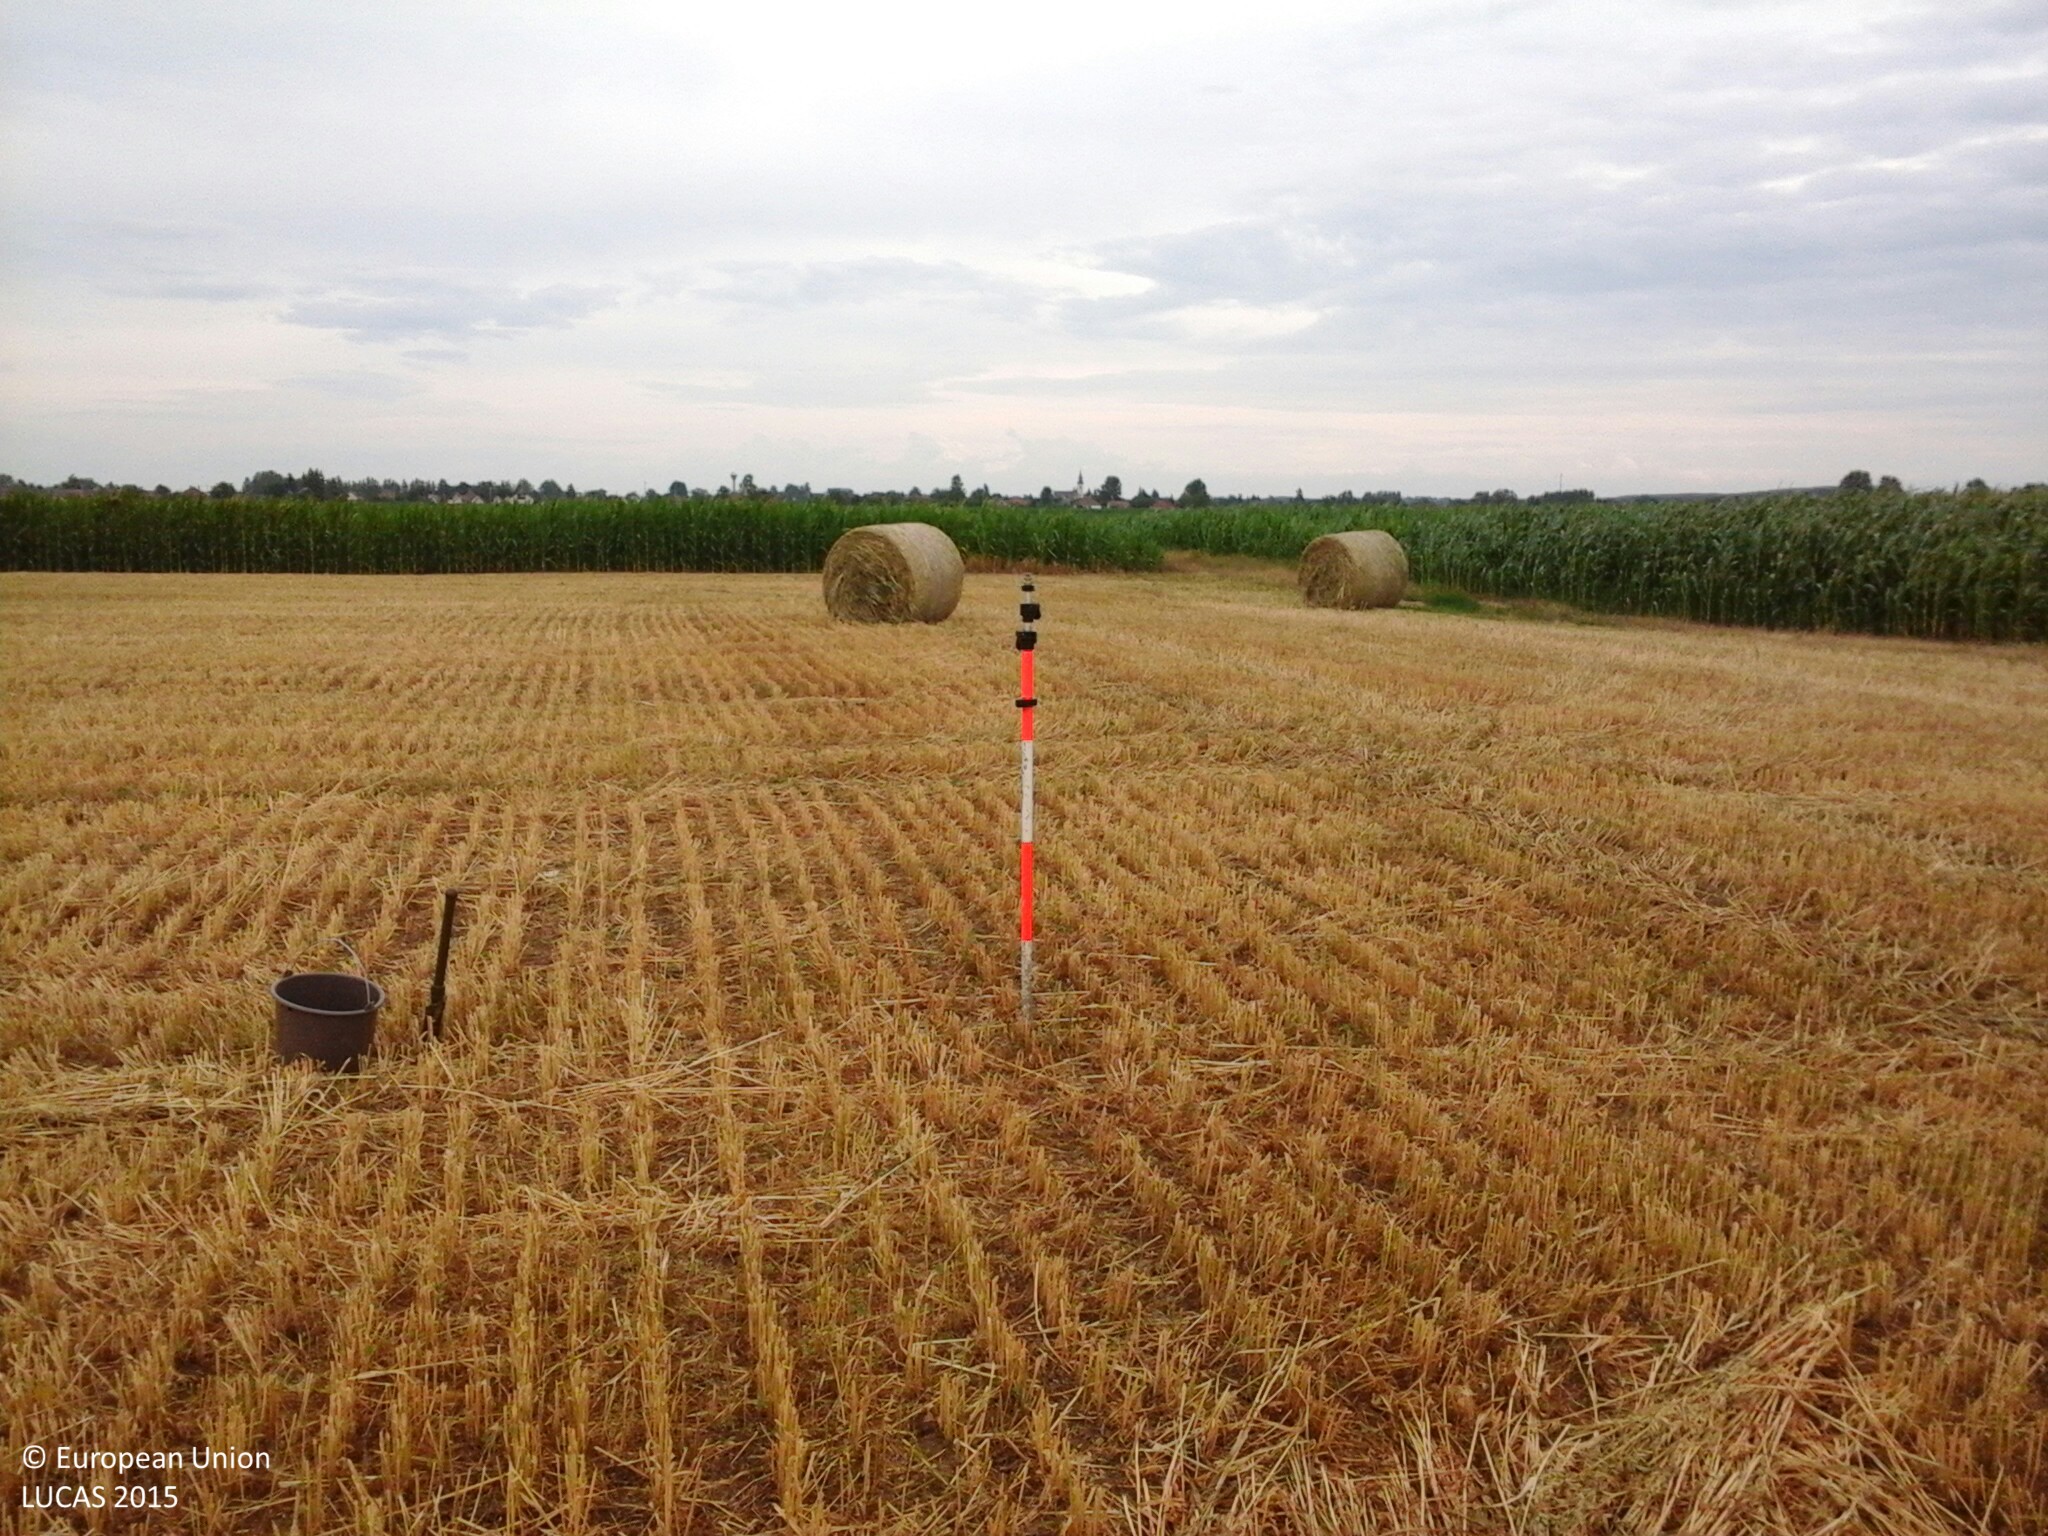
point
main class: Cropland
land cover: Oats
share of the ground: < 10 %
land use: Agriculture (excluding fallow land and kitchen gardens)
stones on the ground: < 10 %
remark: Harvested field
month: July
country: HU
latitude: 48.2533
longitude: 21.8630
